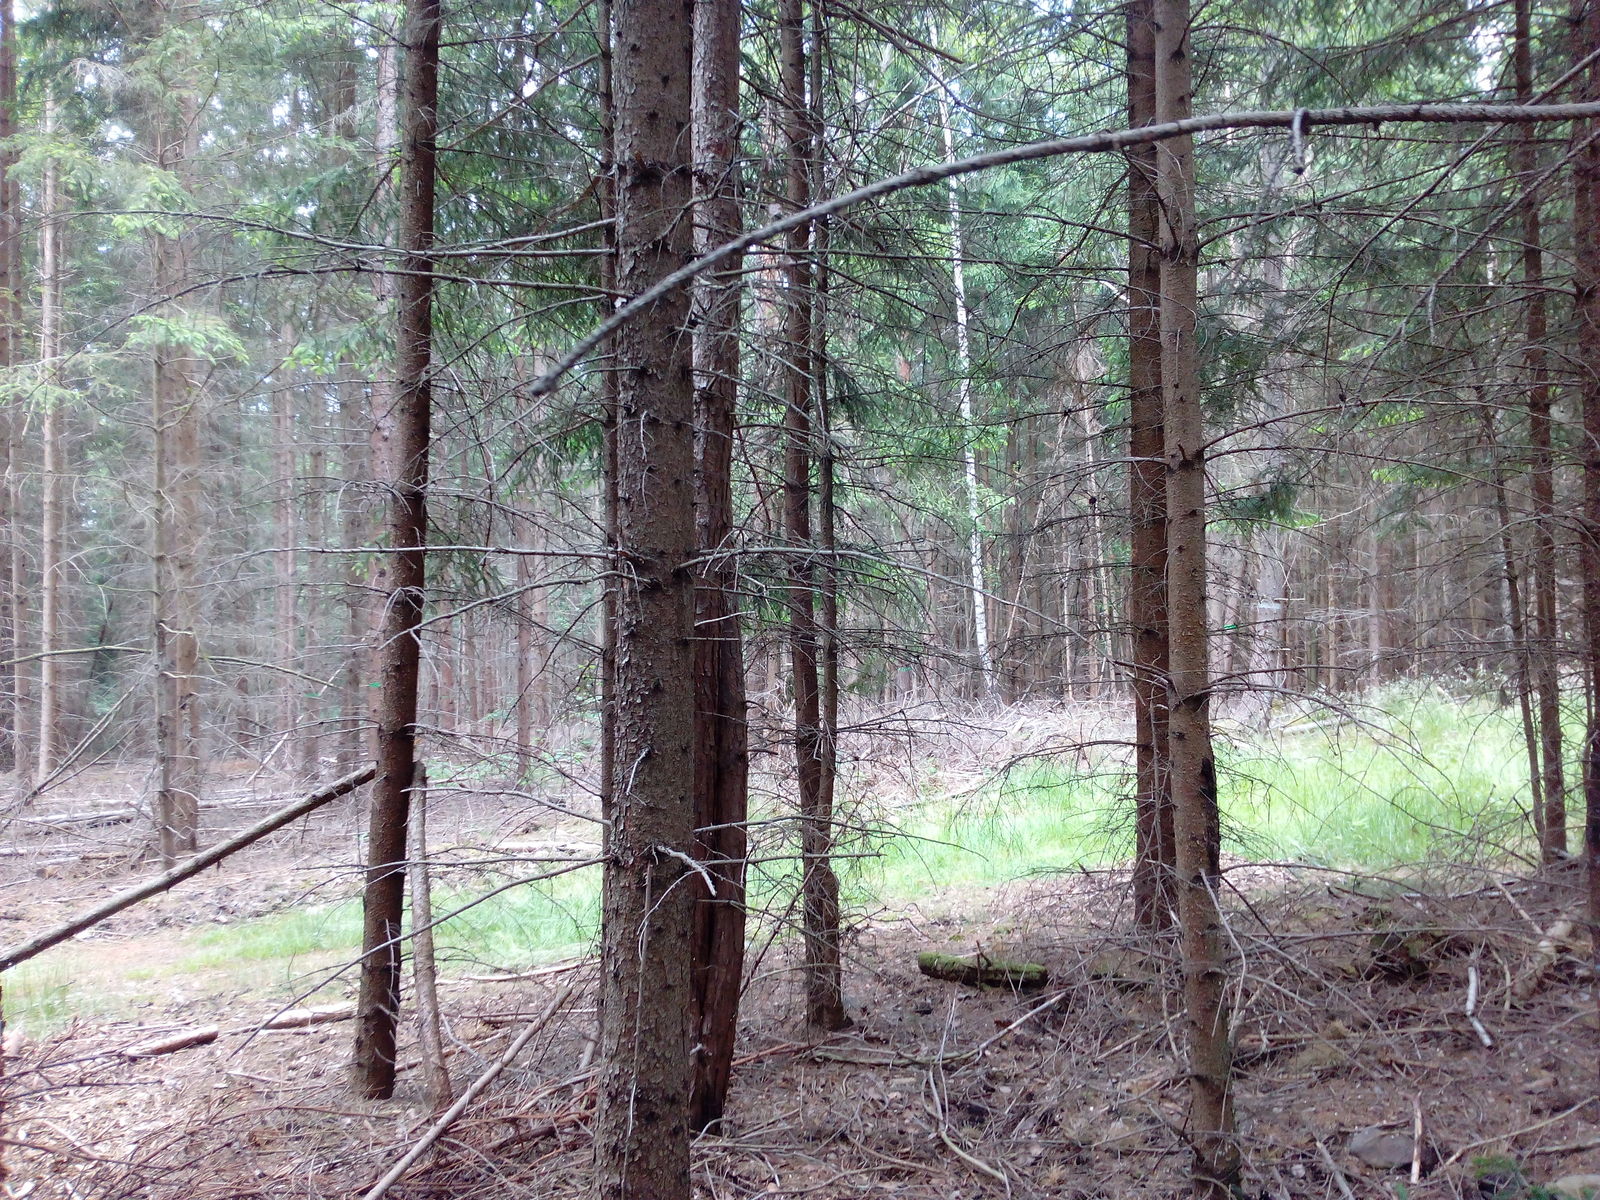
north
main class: Woodland
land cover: Spruce dominated coniferous woodland
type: hemiboreal forest and nemoral coniferous forest and mixed broadleaved-coniferous forest
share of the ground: > 75 %
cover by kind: coniferous forest trees 95 %, broadleaved forest trees 5 %
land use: Forestry
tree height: > 5 m
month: June
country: DE
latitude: 50.7566
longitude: 10.8361
